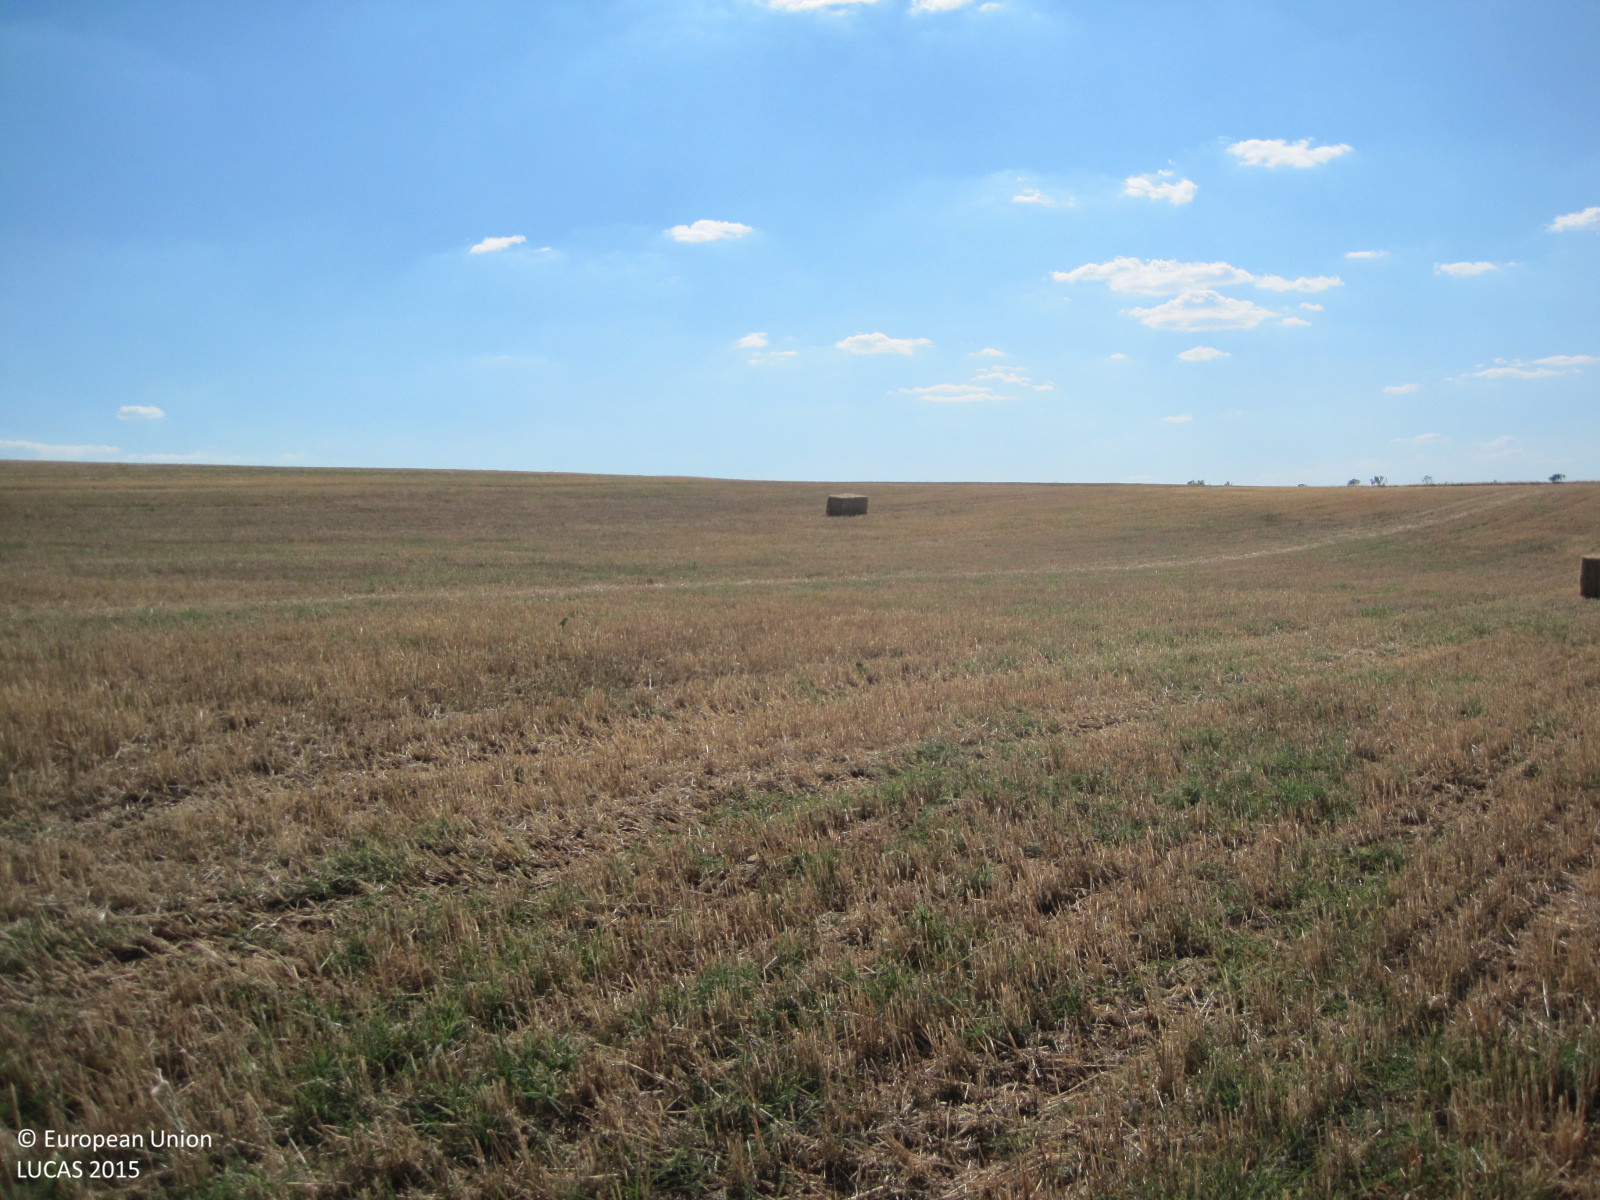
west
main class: Cropland
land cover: Barley
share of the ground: < 10 %
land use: Agriculture (excluding fallow land and kitchen gardens)
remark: Harvested field
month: June
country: ES
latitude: 39.9245
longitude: -4.2070
